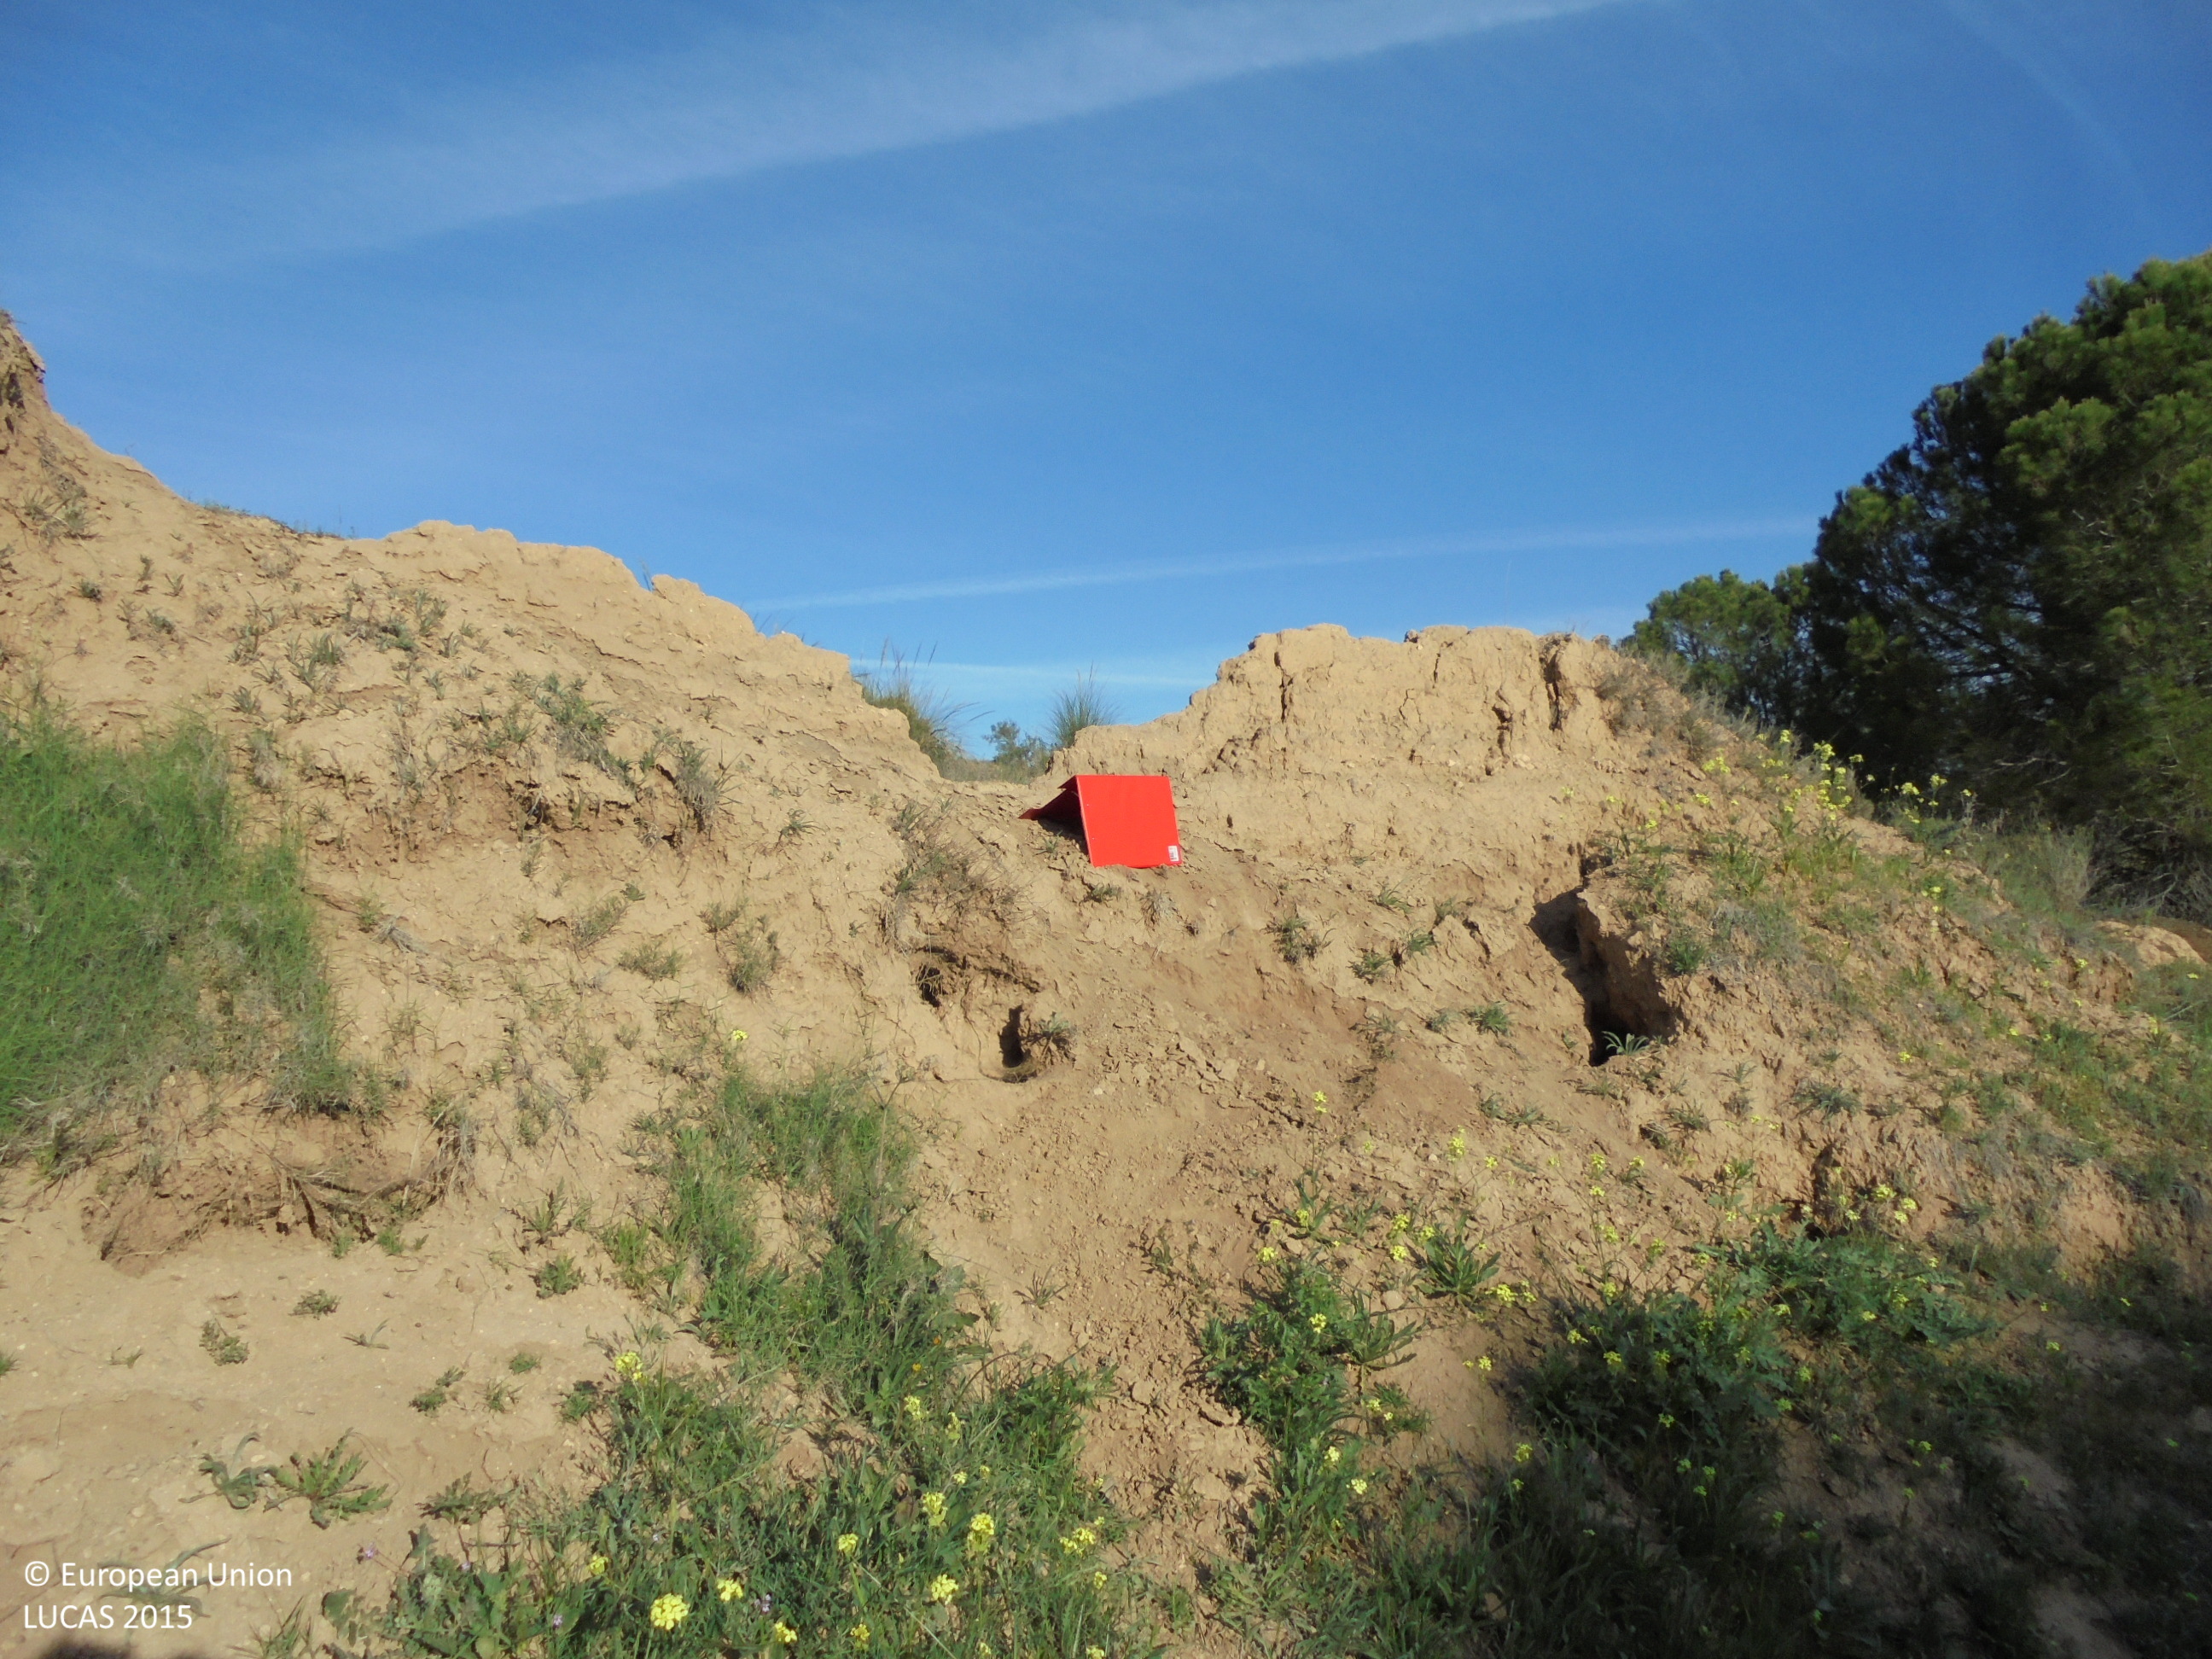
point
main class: Shrubland
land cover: Shrubland with sparse tree cover
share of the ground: 10 - 25 %
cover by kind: herbaceous plants 75 %, shrubs 15 %, coniferous forest trees 5 %, unconsolidated bare surface 5 %
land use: Semi-natural and natural areas not in use
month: May
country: ES
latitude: 39.1598
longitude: -1.7247
